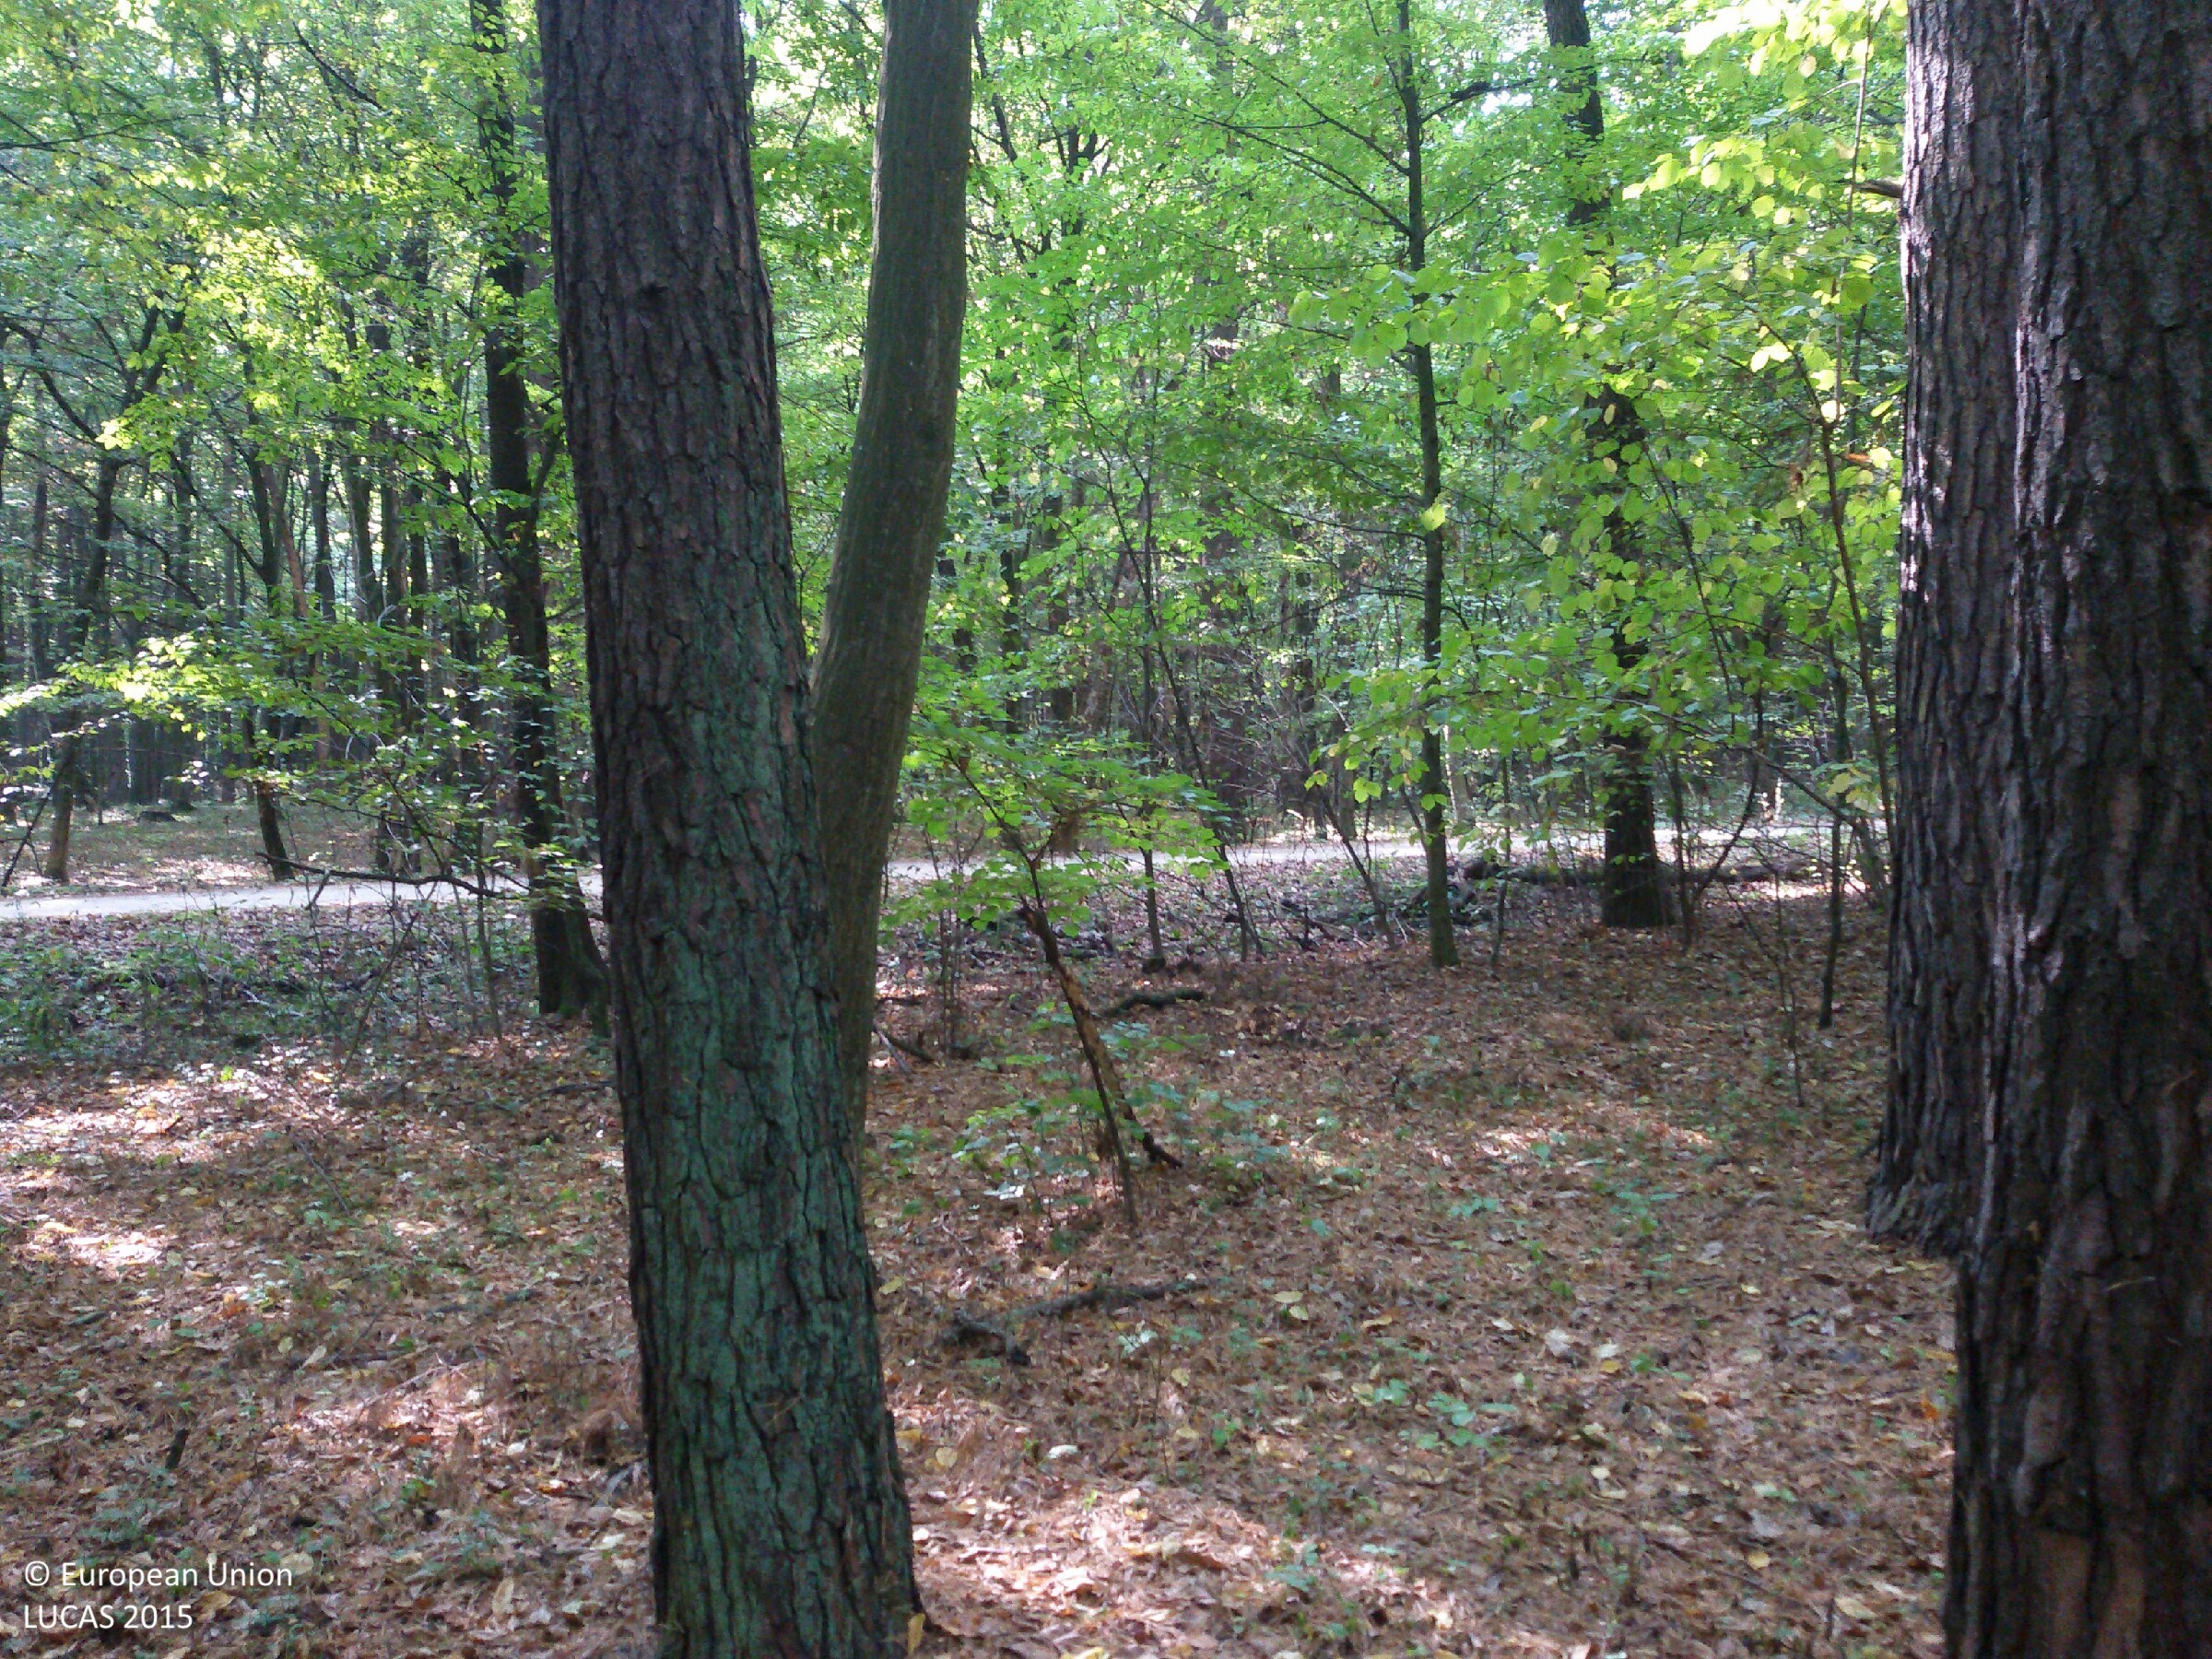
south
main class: Woodland
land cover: Broadleaved woodland
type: mesophytic deciduous forest
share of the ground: > 75 %
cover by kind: broadleaved forest trees 90 %, herbaceous plants 10 %
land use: Forestry
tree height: > 5 m
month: September
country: PL
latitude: 50.7078
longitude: 23.9564
